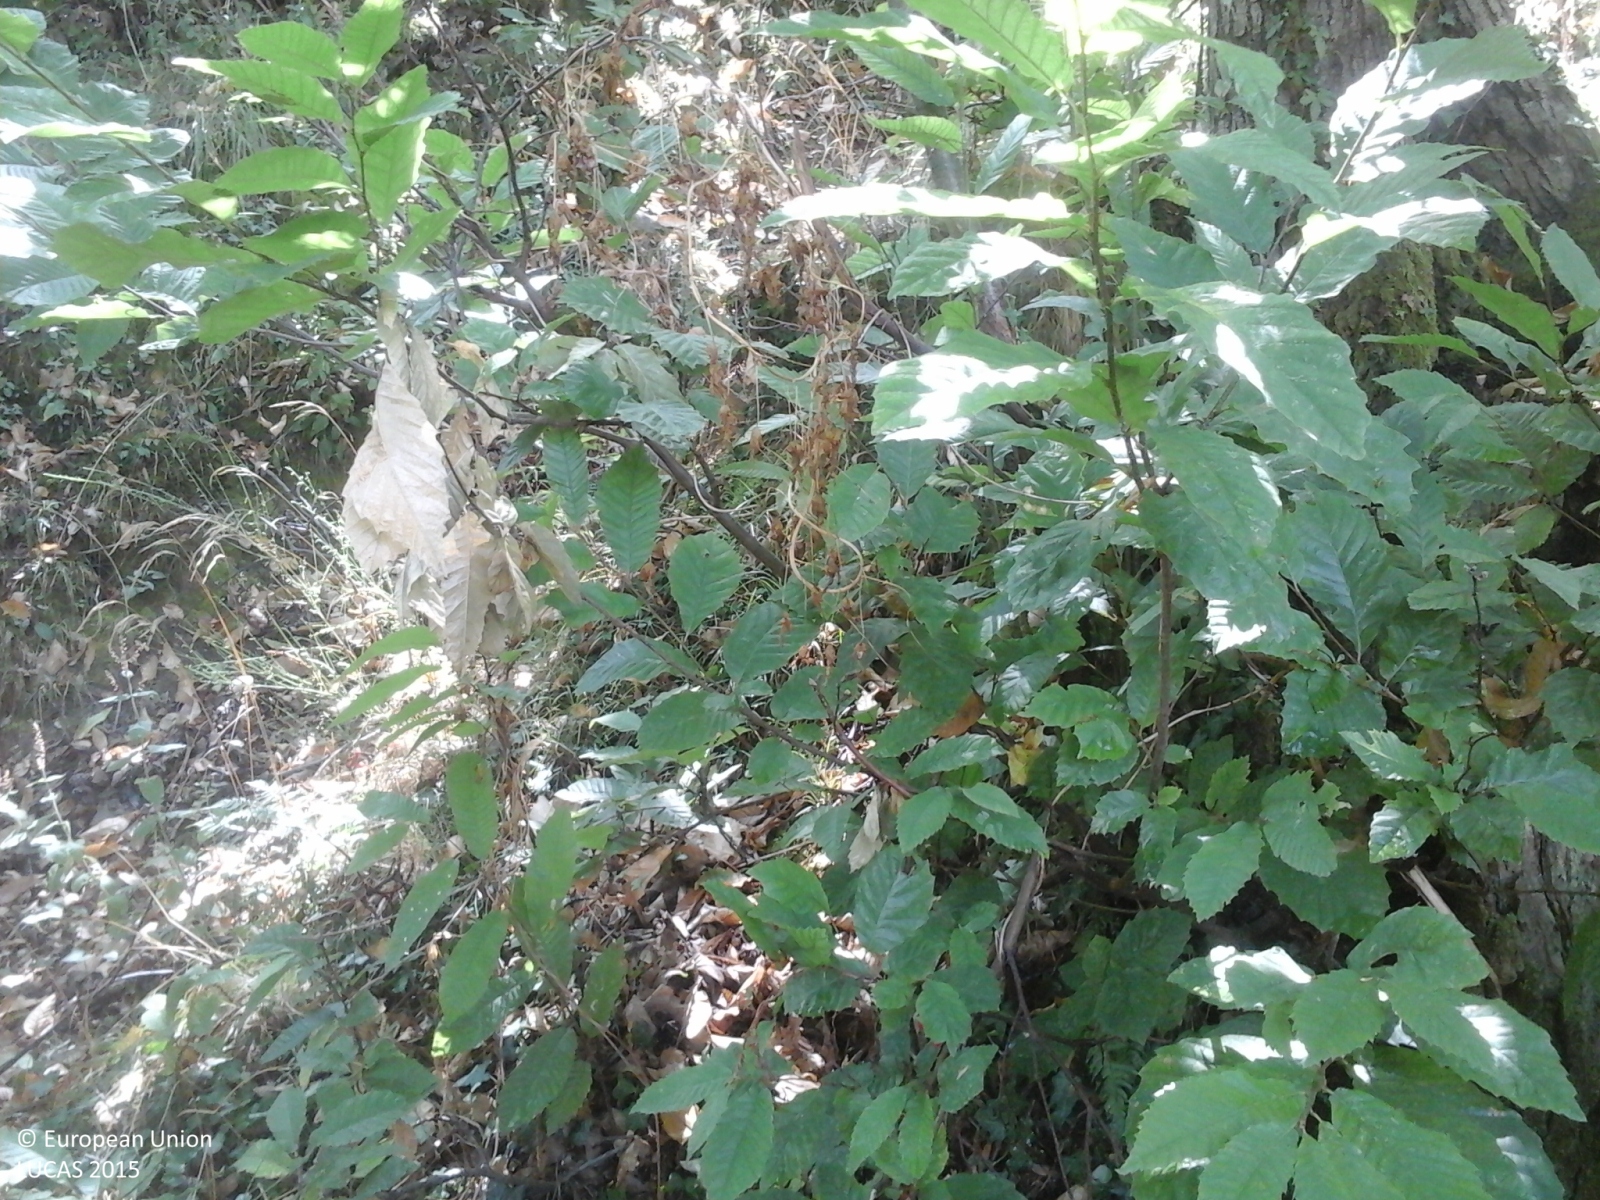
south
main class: Woodland
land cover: Broadleaved woodland
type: thermophilous deciduous forest
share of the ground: > 75 %
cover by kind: broadleaved forest trees 100 %
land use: Forestry
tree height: > 5 m
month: August
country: IT
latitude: 43.8230
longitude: 10.9549
